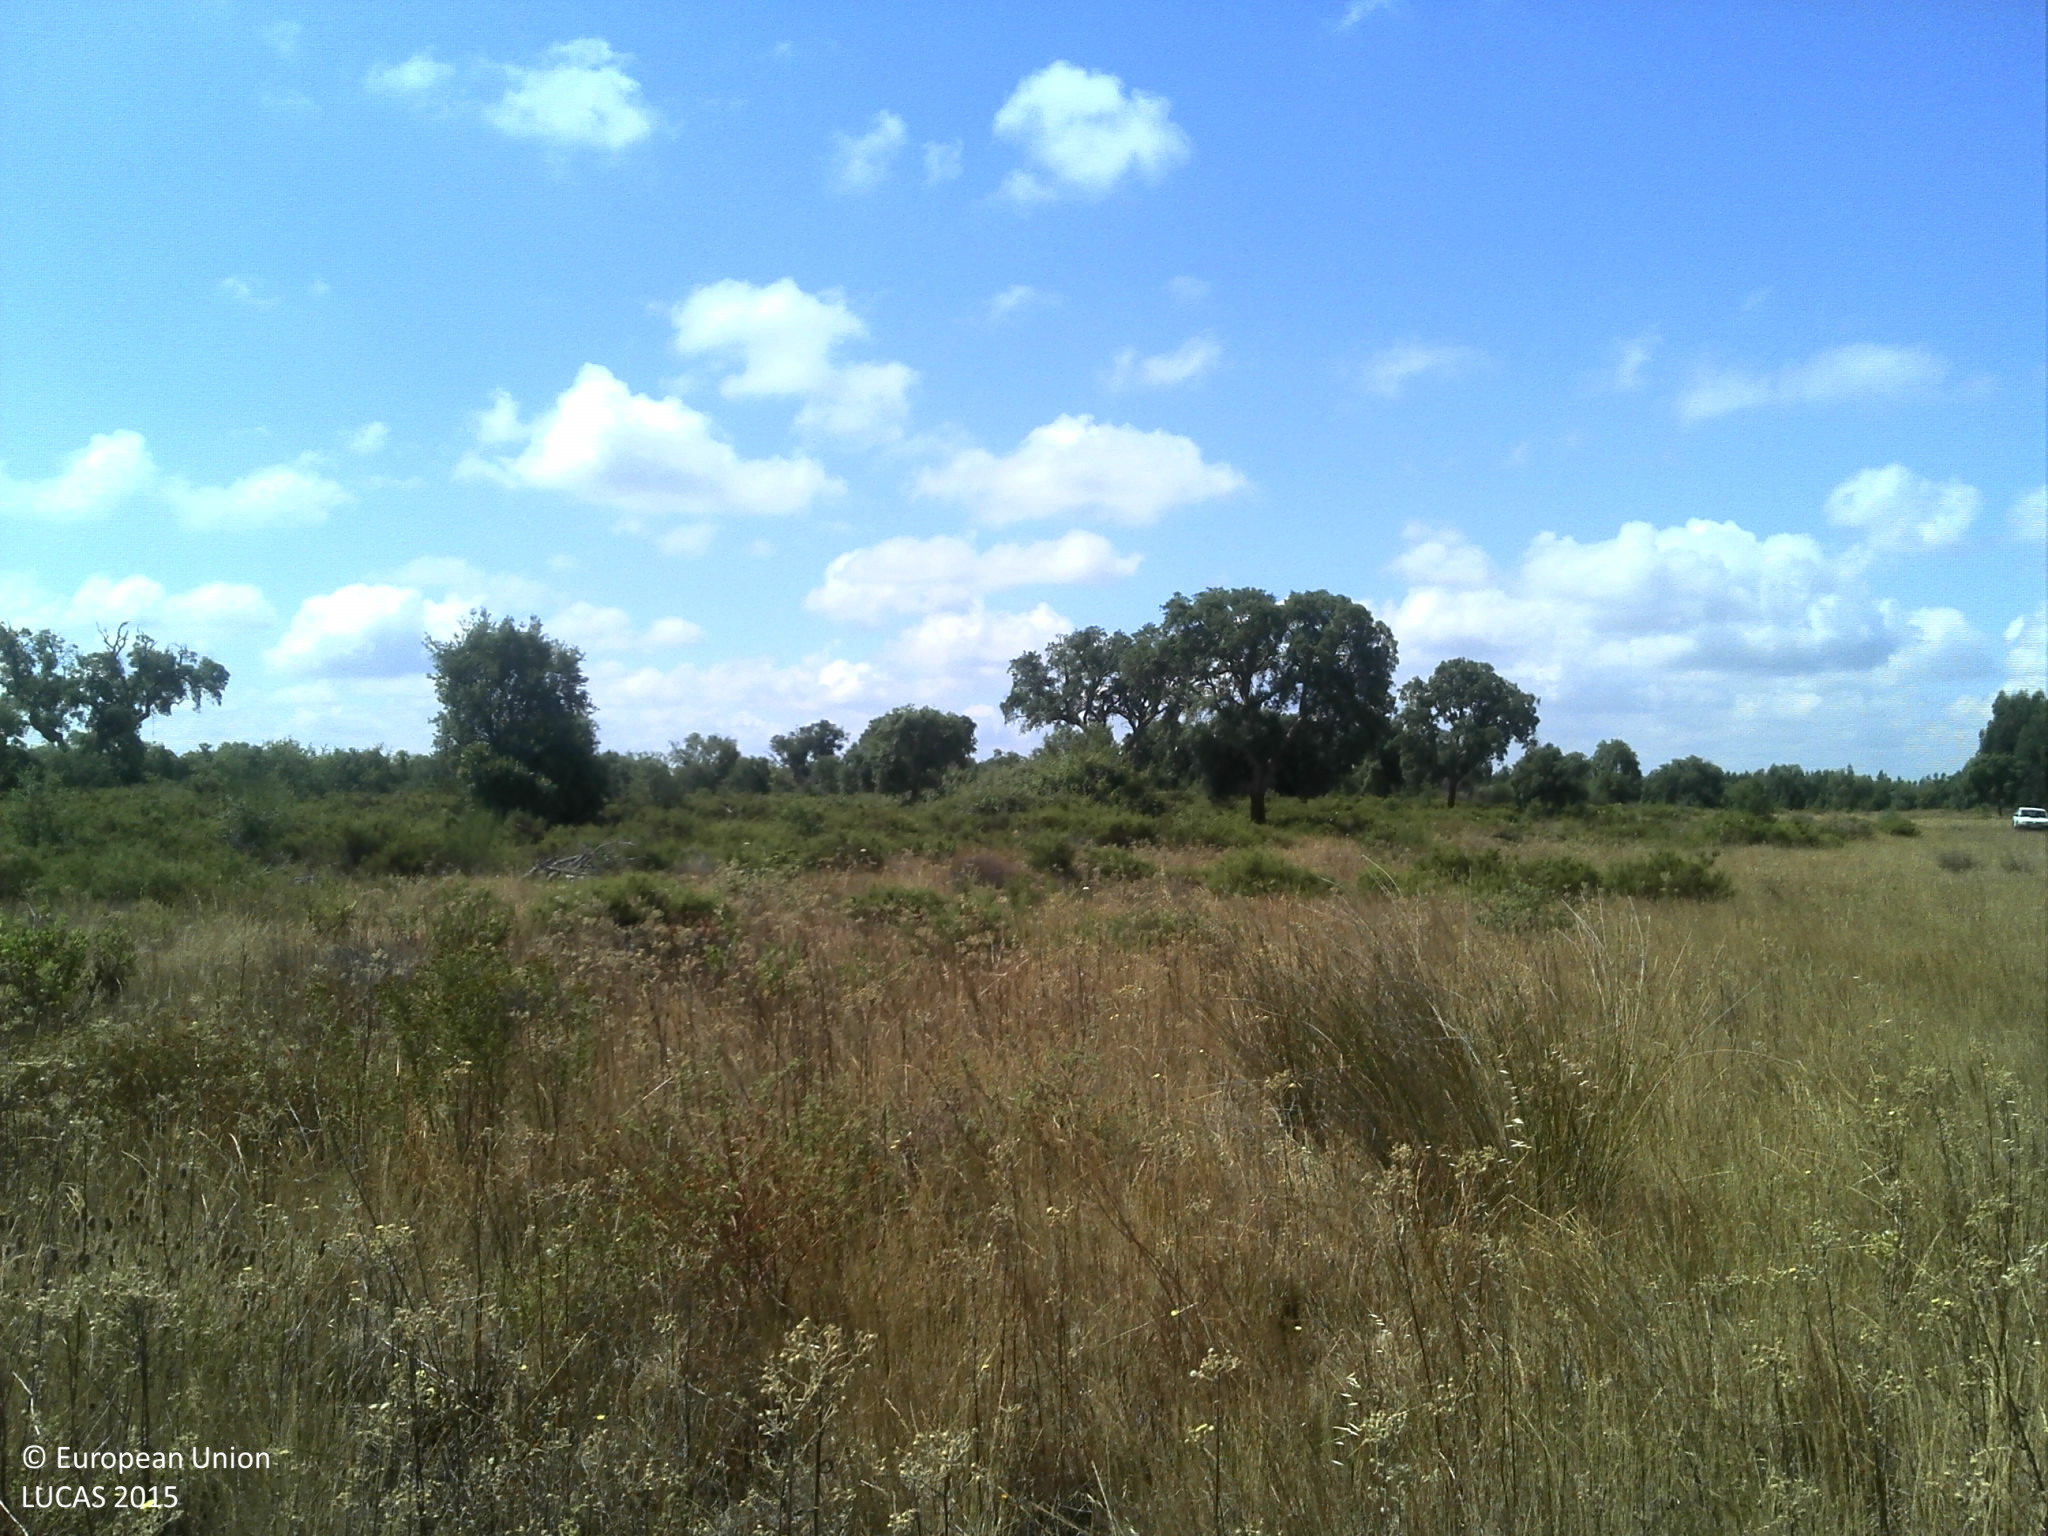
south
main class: Grassland
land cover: Grassland without tree/shrub cover
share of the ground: 50 - 75 %
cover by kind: herbaceous plants 75 %, consolidated bare surface 25 %
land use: Agriculture (excluding fallow land and kitchen gardens)
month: June
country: PT
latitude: 39.3182
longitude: -8.2374
